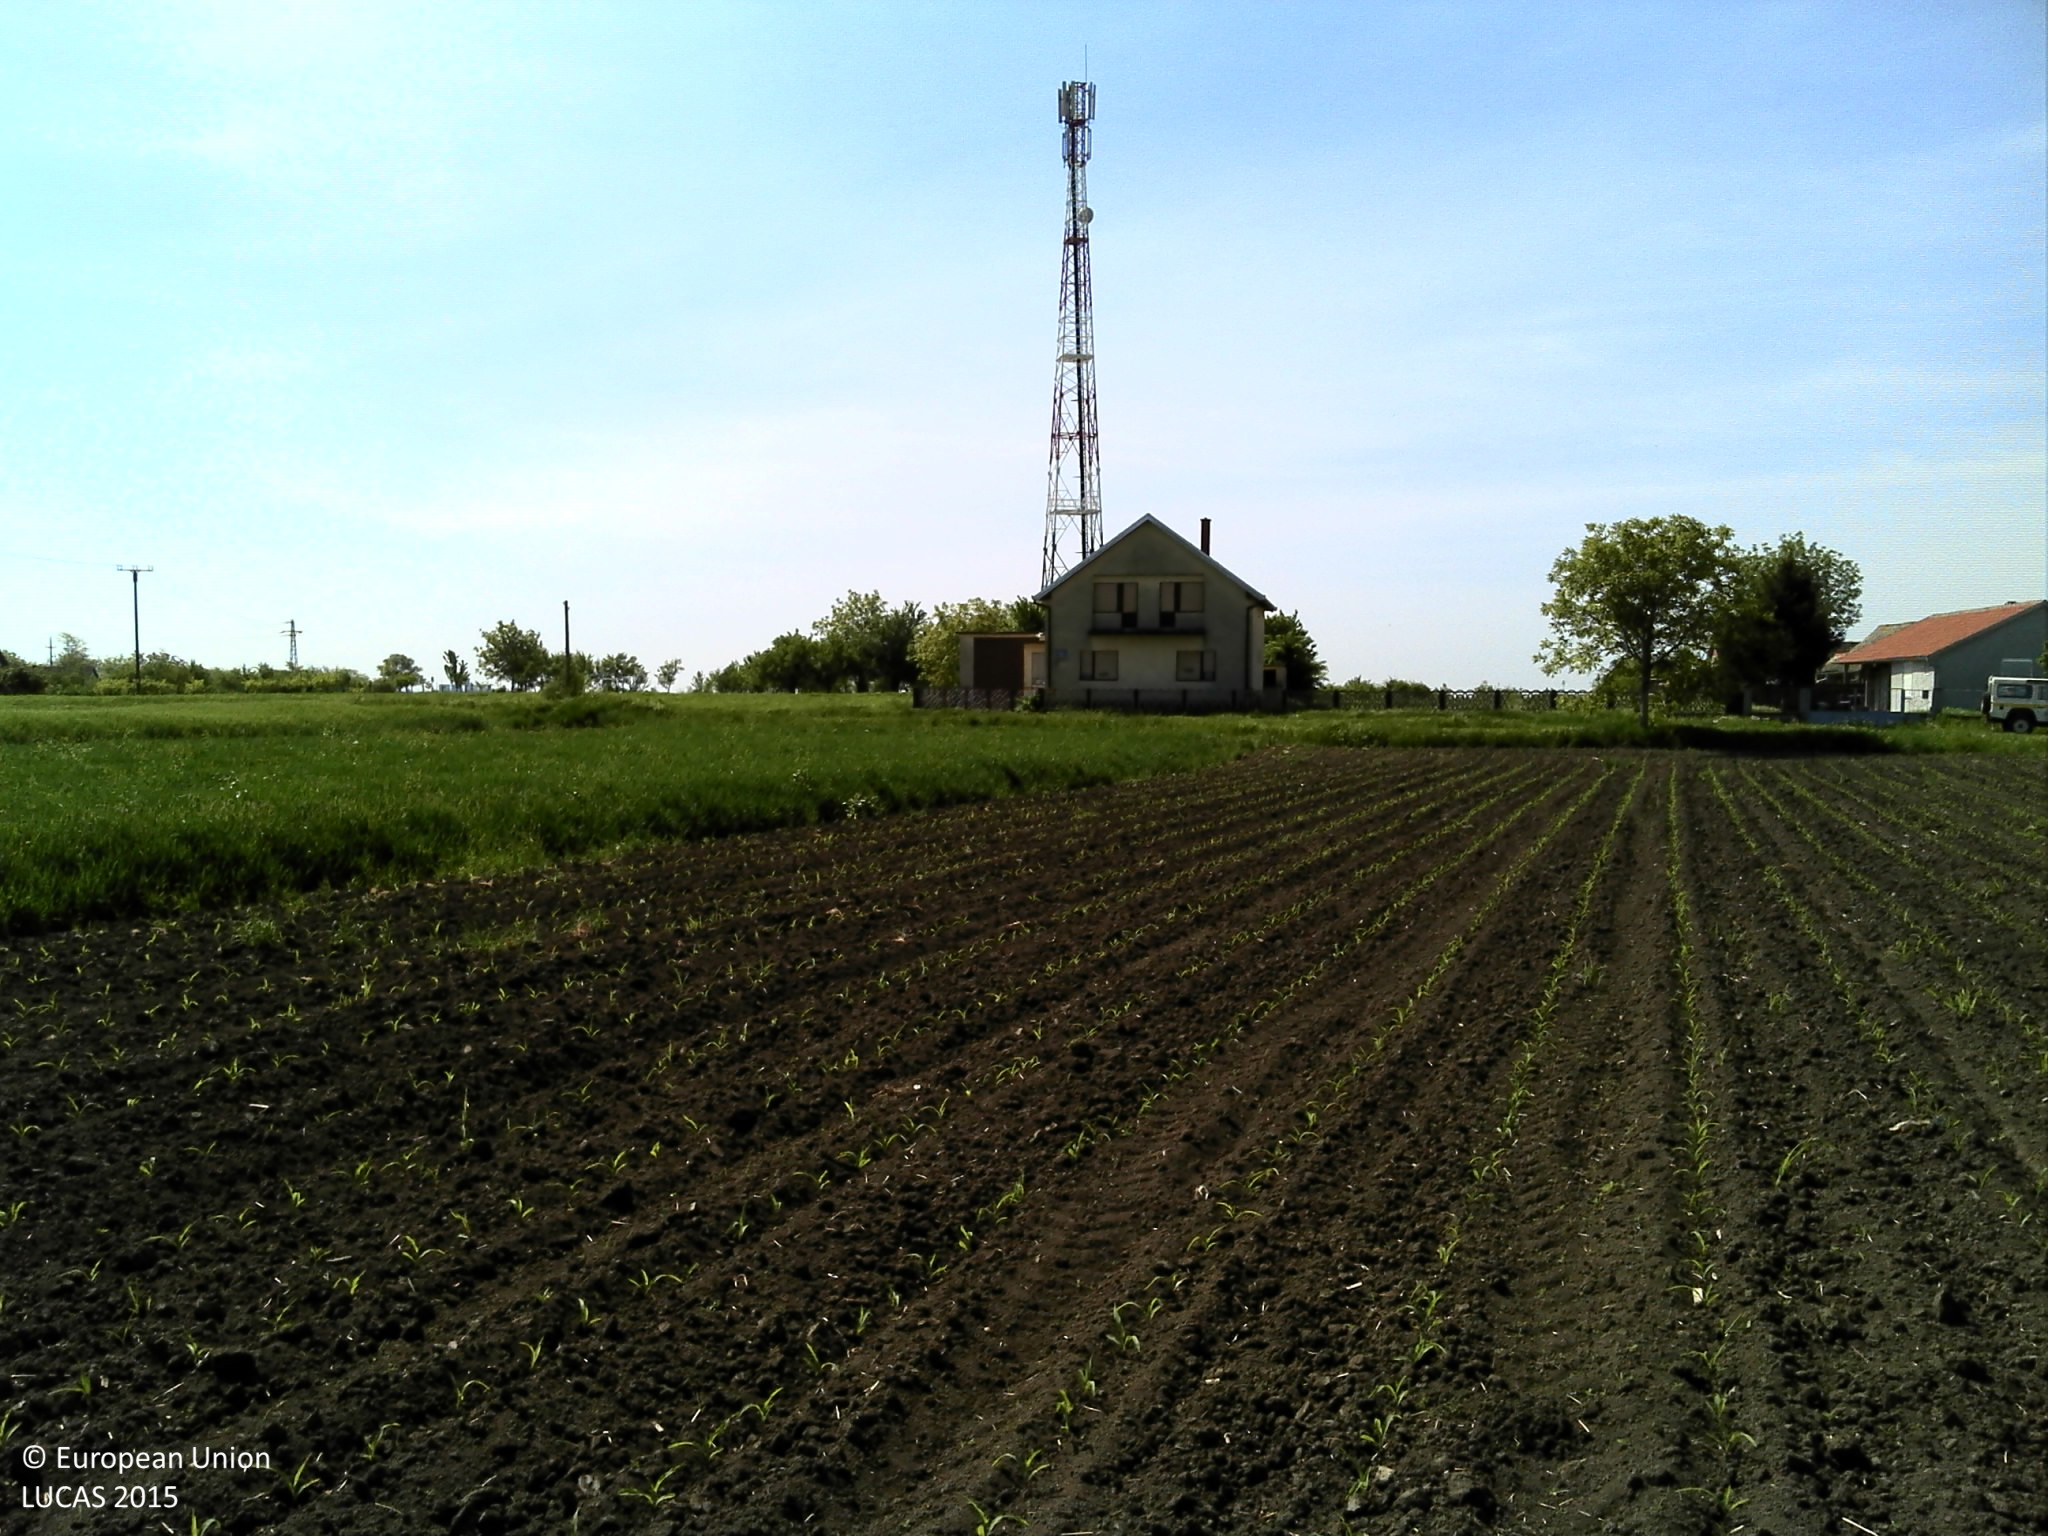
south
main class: Cropland
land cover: Maize
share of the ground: < 10 %
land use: Agriculture (excluding fallow land and kitchen gardens)
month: May
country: HR
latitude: 45.4187
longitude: 18.8900
